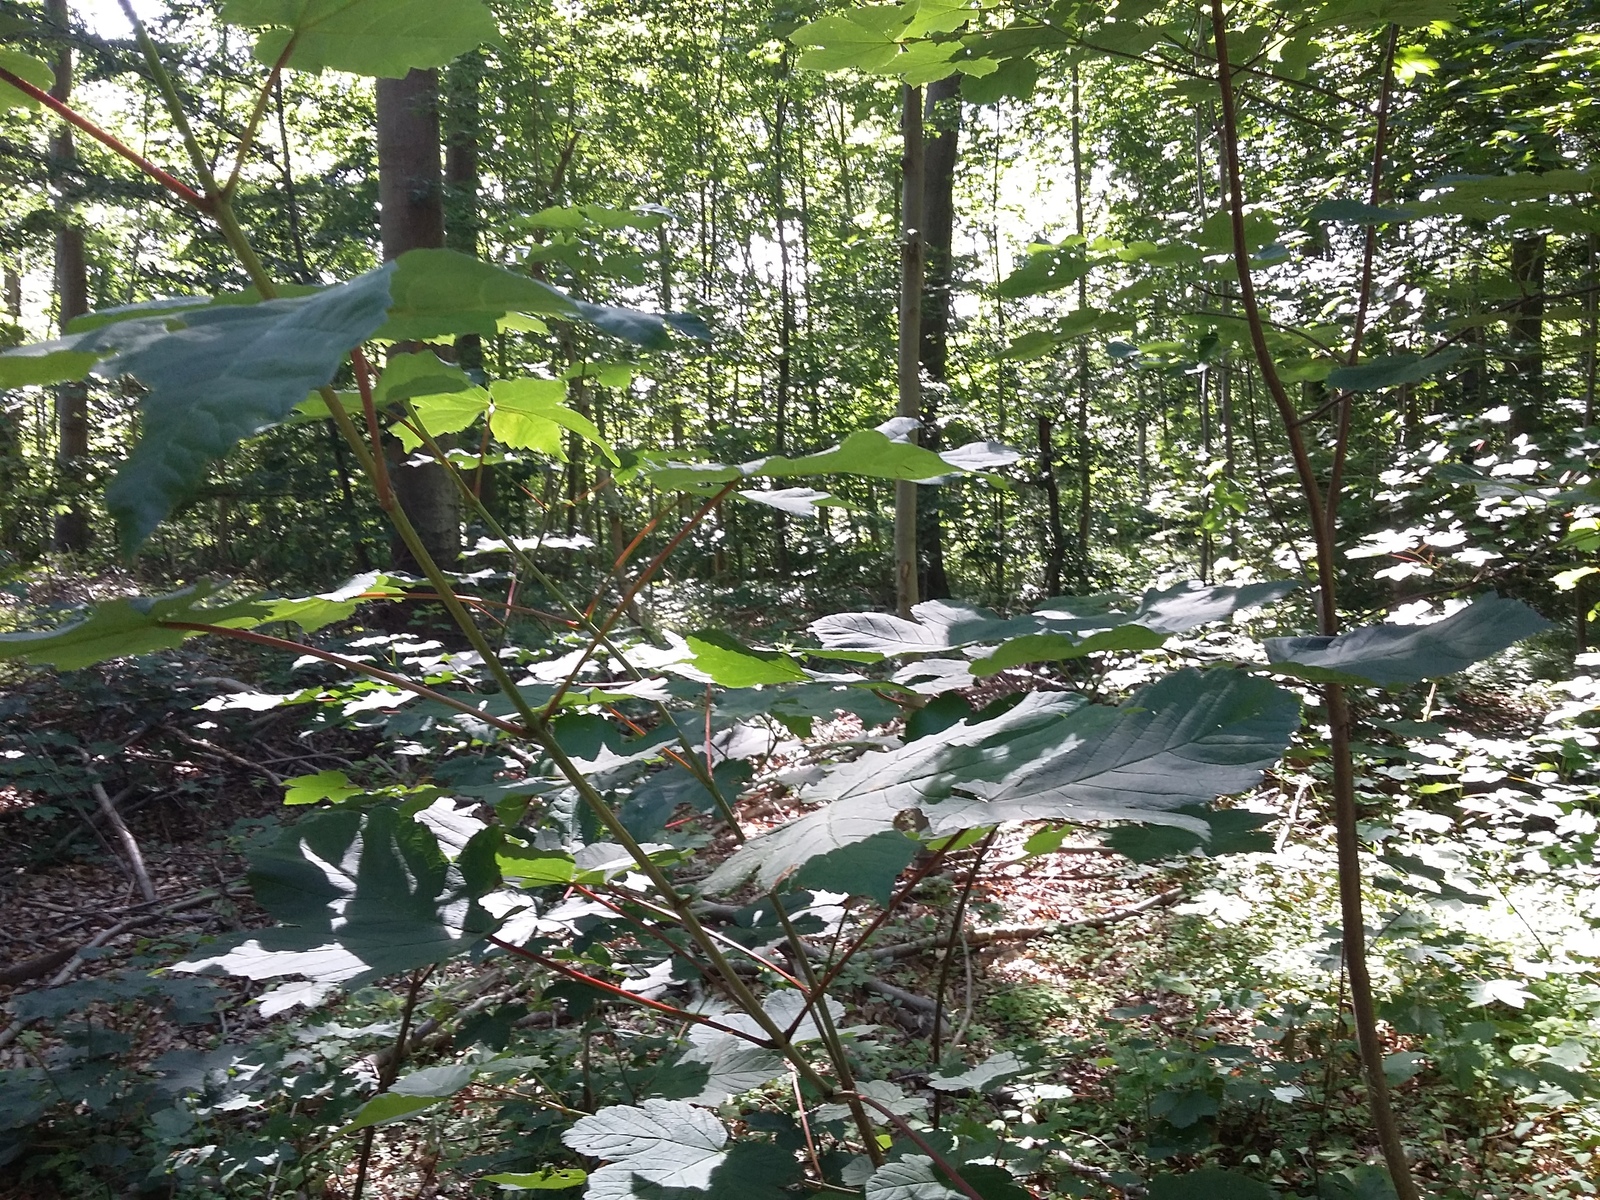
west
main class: Woodland
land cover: Broadleaved woodland
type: beech forest
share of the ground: > 75 %
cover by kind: broadleaved forest trees 80 %, herbaceous plants 20 %
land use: Forestry
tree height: > 5 m
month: June
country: DK
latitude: 54.8255
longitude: 11.8822
